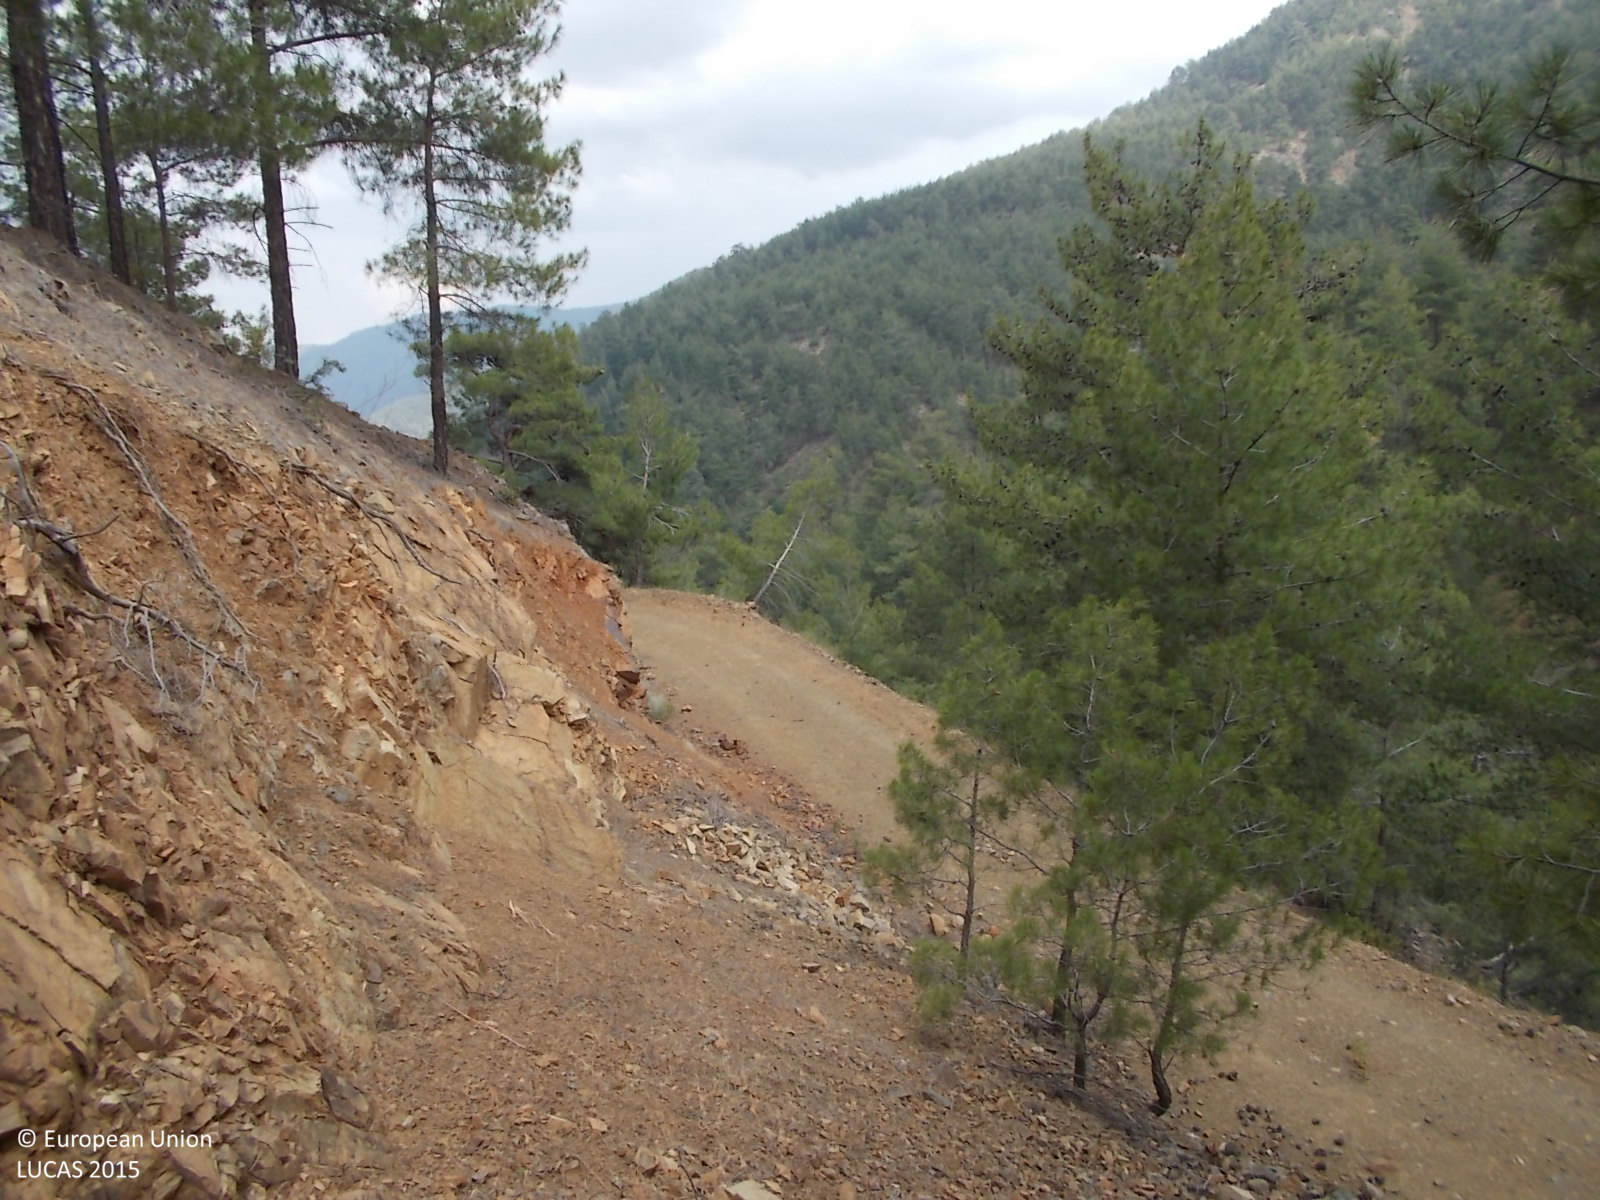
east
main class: Woodland
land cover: Pine dominated coniferous woodland
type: coniferous forest of the mediterranean region
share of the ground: > 75 %
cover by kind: coniferous forest trees 75 %, unconsolidated bare surface 25 %
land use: Forestry
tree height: > 5 m
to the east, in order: Pine dominated coniferous woodland; Paved roads, cycling and walking lanes; Pine dominated coniferous woodland; Rivers and streams; Pine dominated coniferous woodland
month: June
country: CY
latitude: 35.0917
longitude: 32.6385
